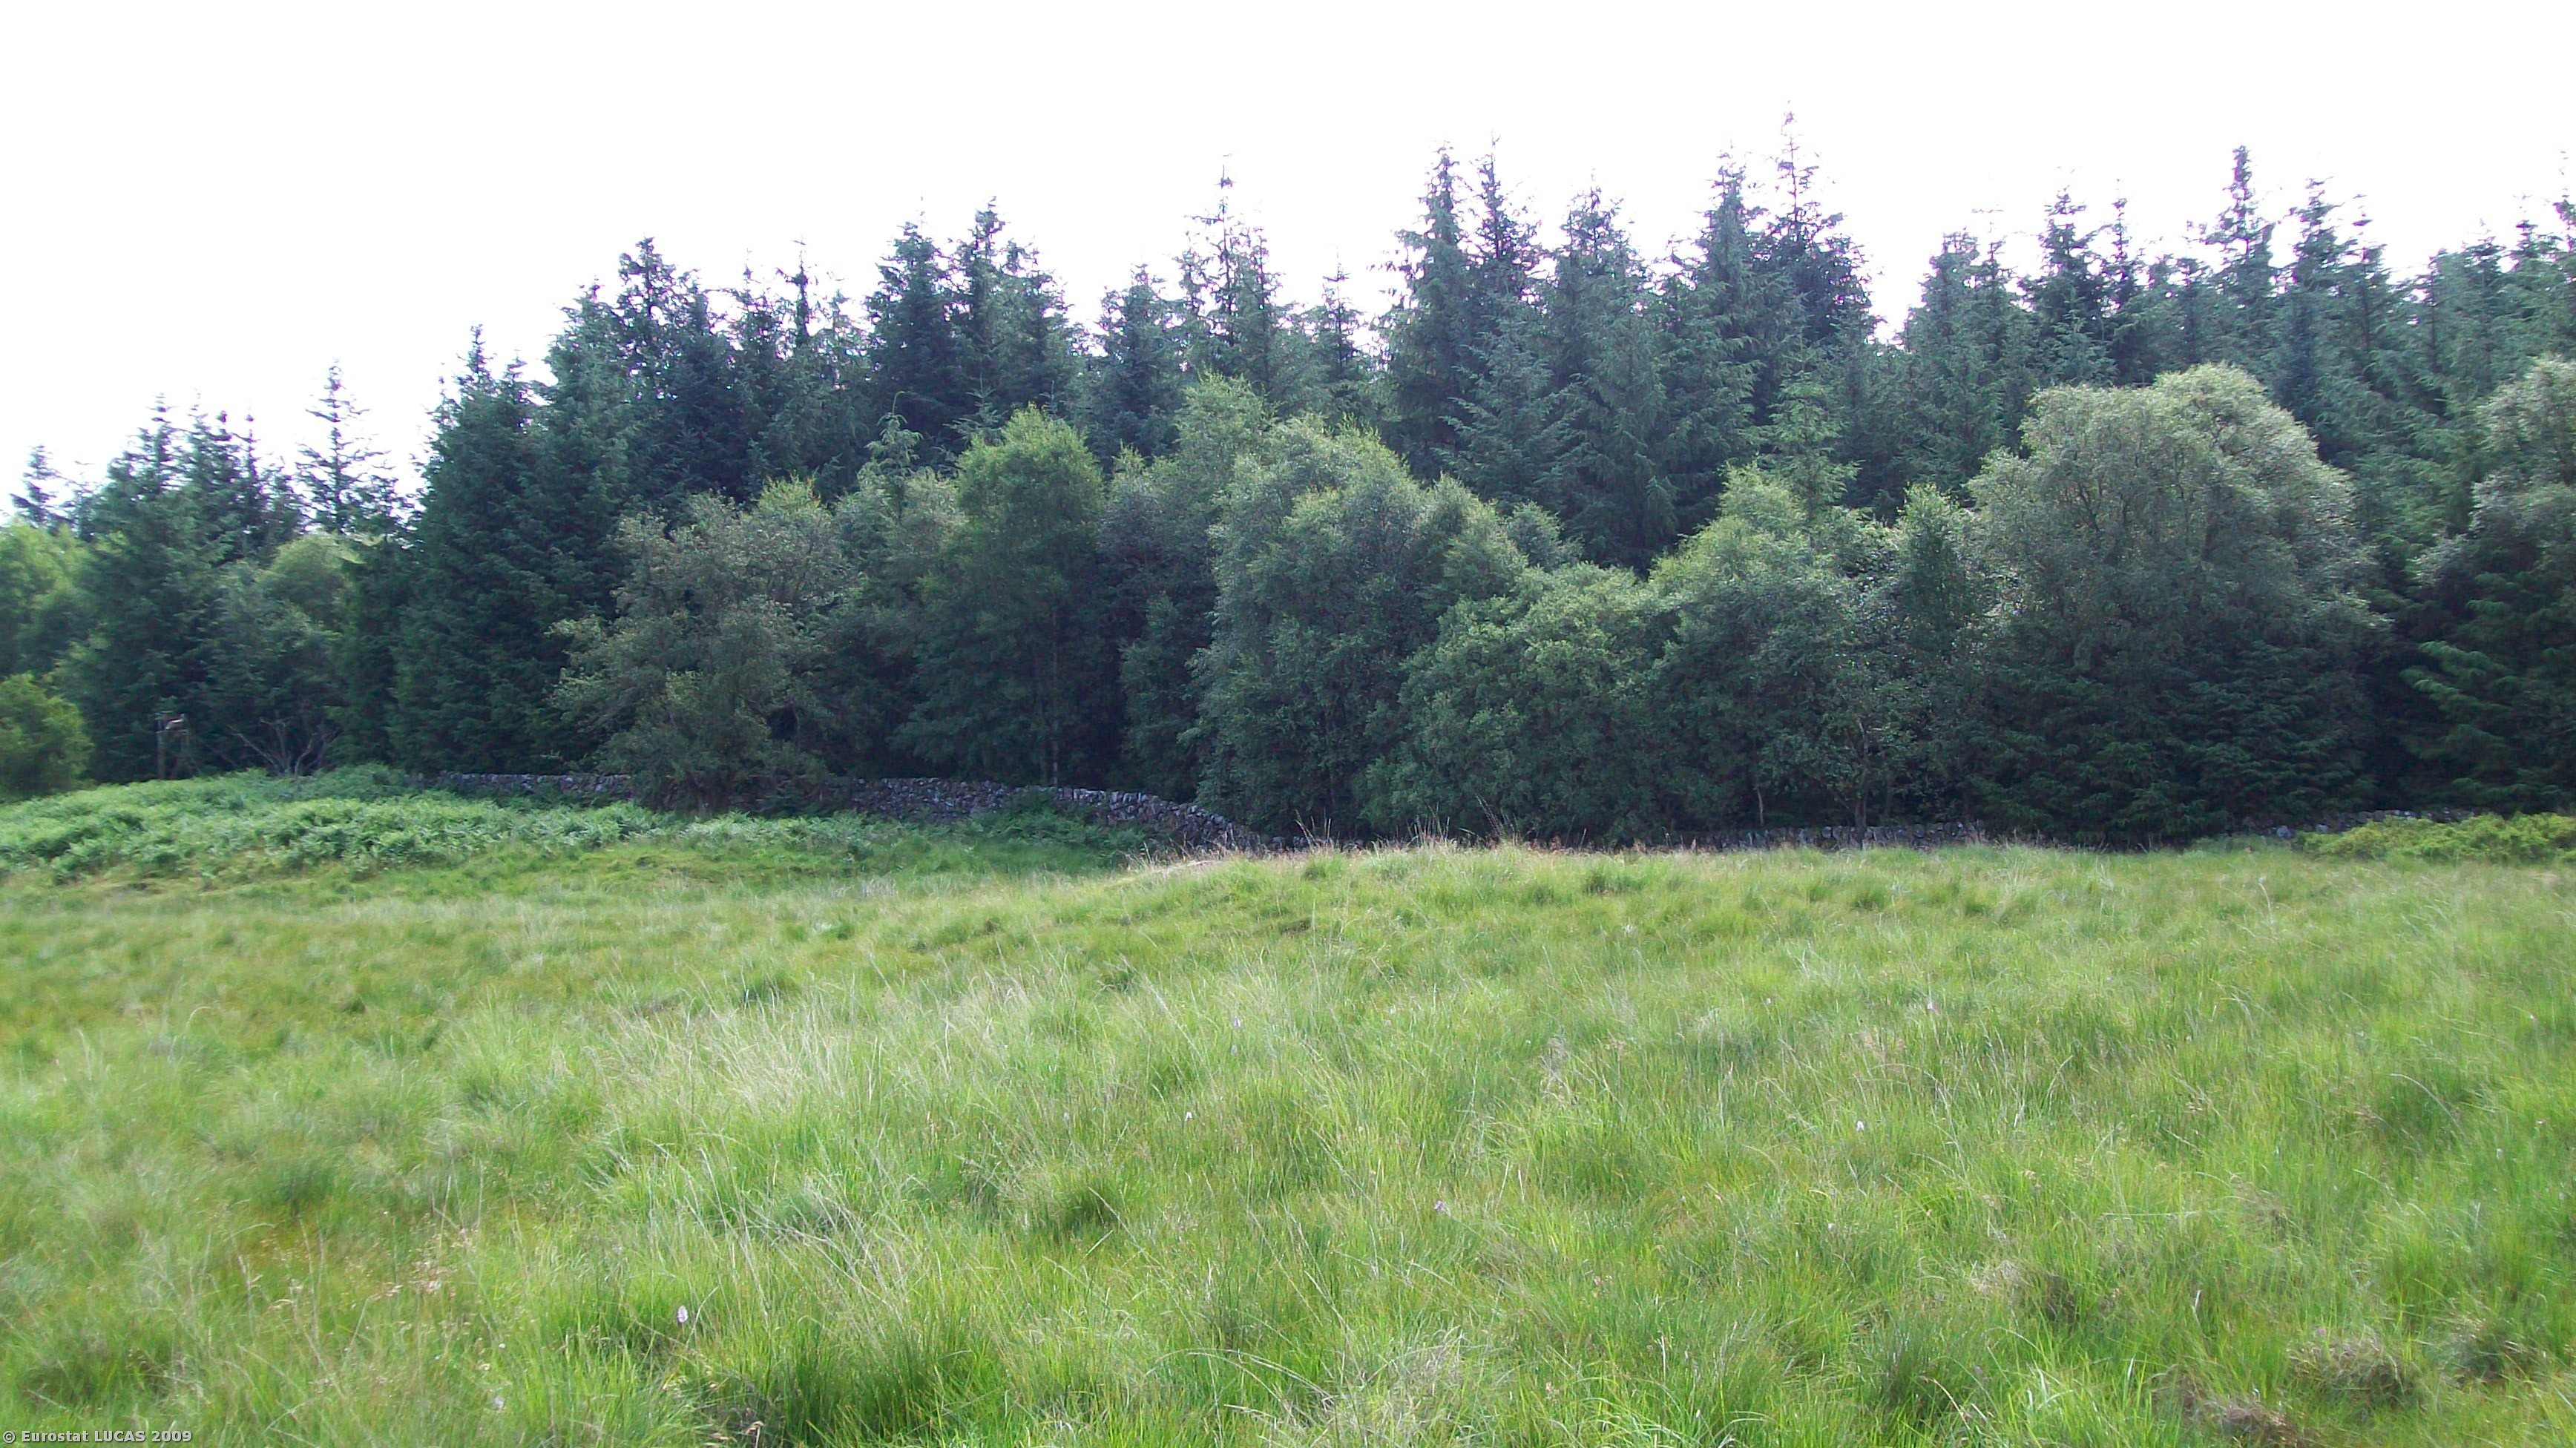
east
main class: Grassland
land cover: Grassland without tree/shrub cover
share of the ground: > 75 %
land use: Agriculture (excluding fallow land and kitchen gardens)
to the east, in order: Grassland without tree/shrub cover; Peatbogs; Grassland with sparse tree/shrub cover; Dry stone walls; Mixed woodland; Coniferous woodland
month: July
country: GB
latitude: 55.0208
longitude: -4.0914
